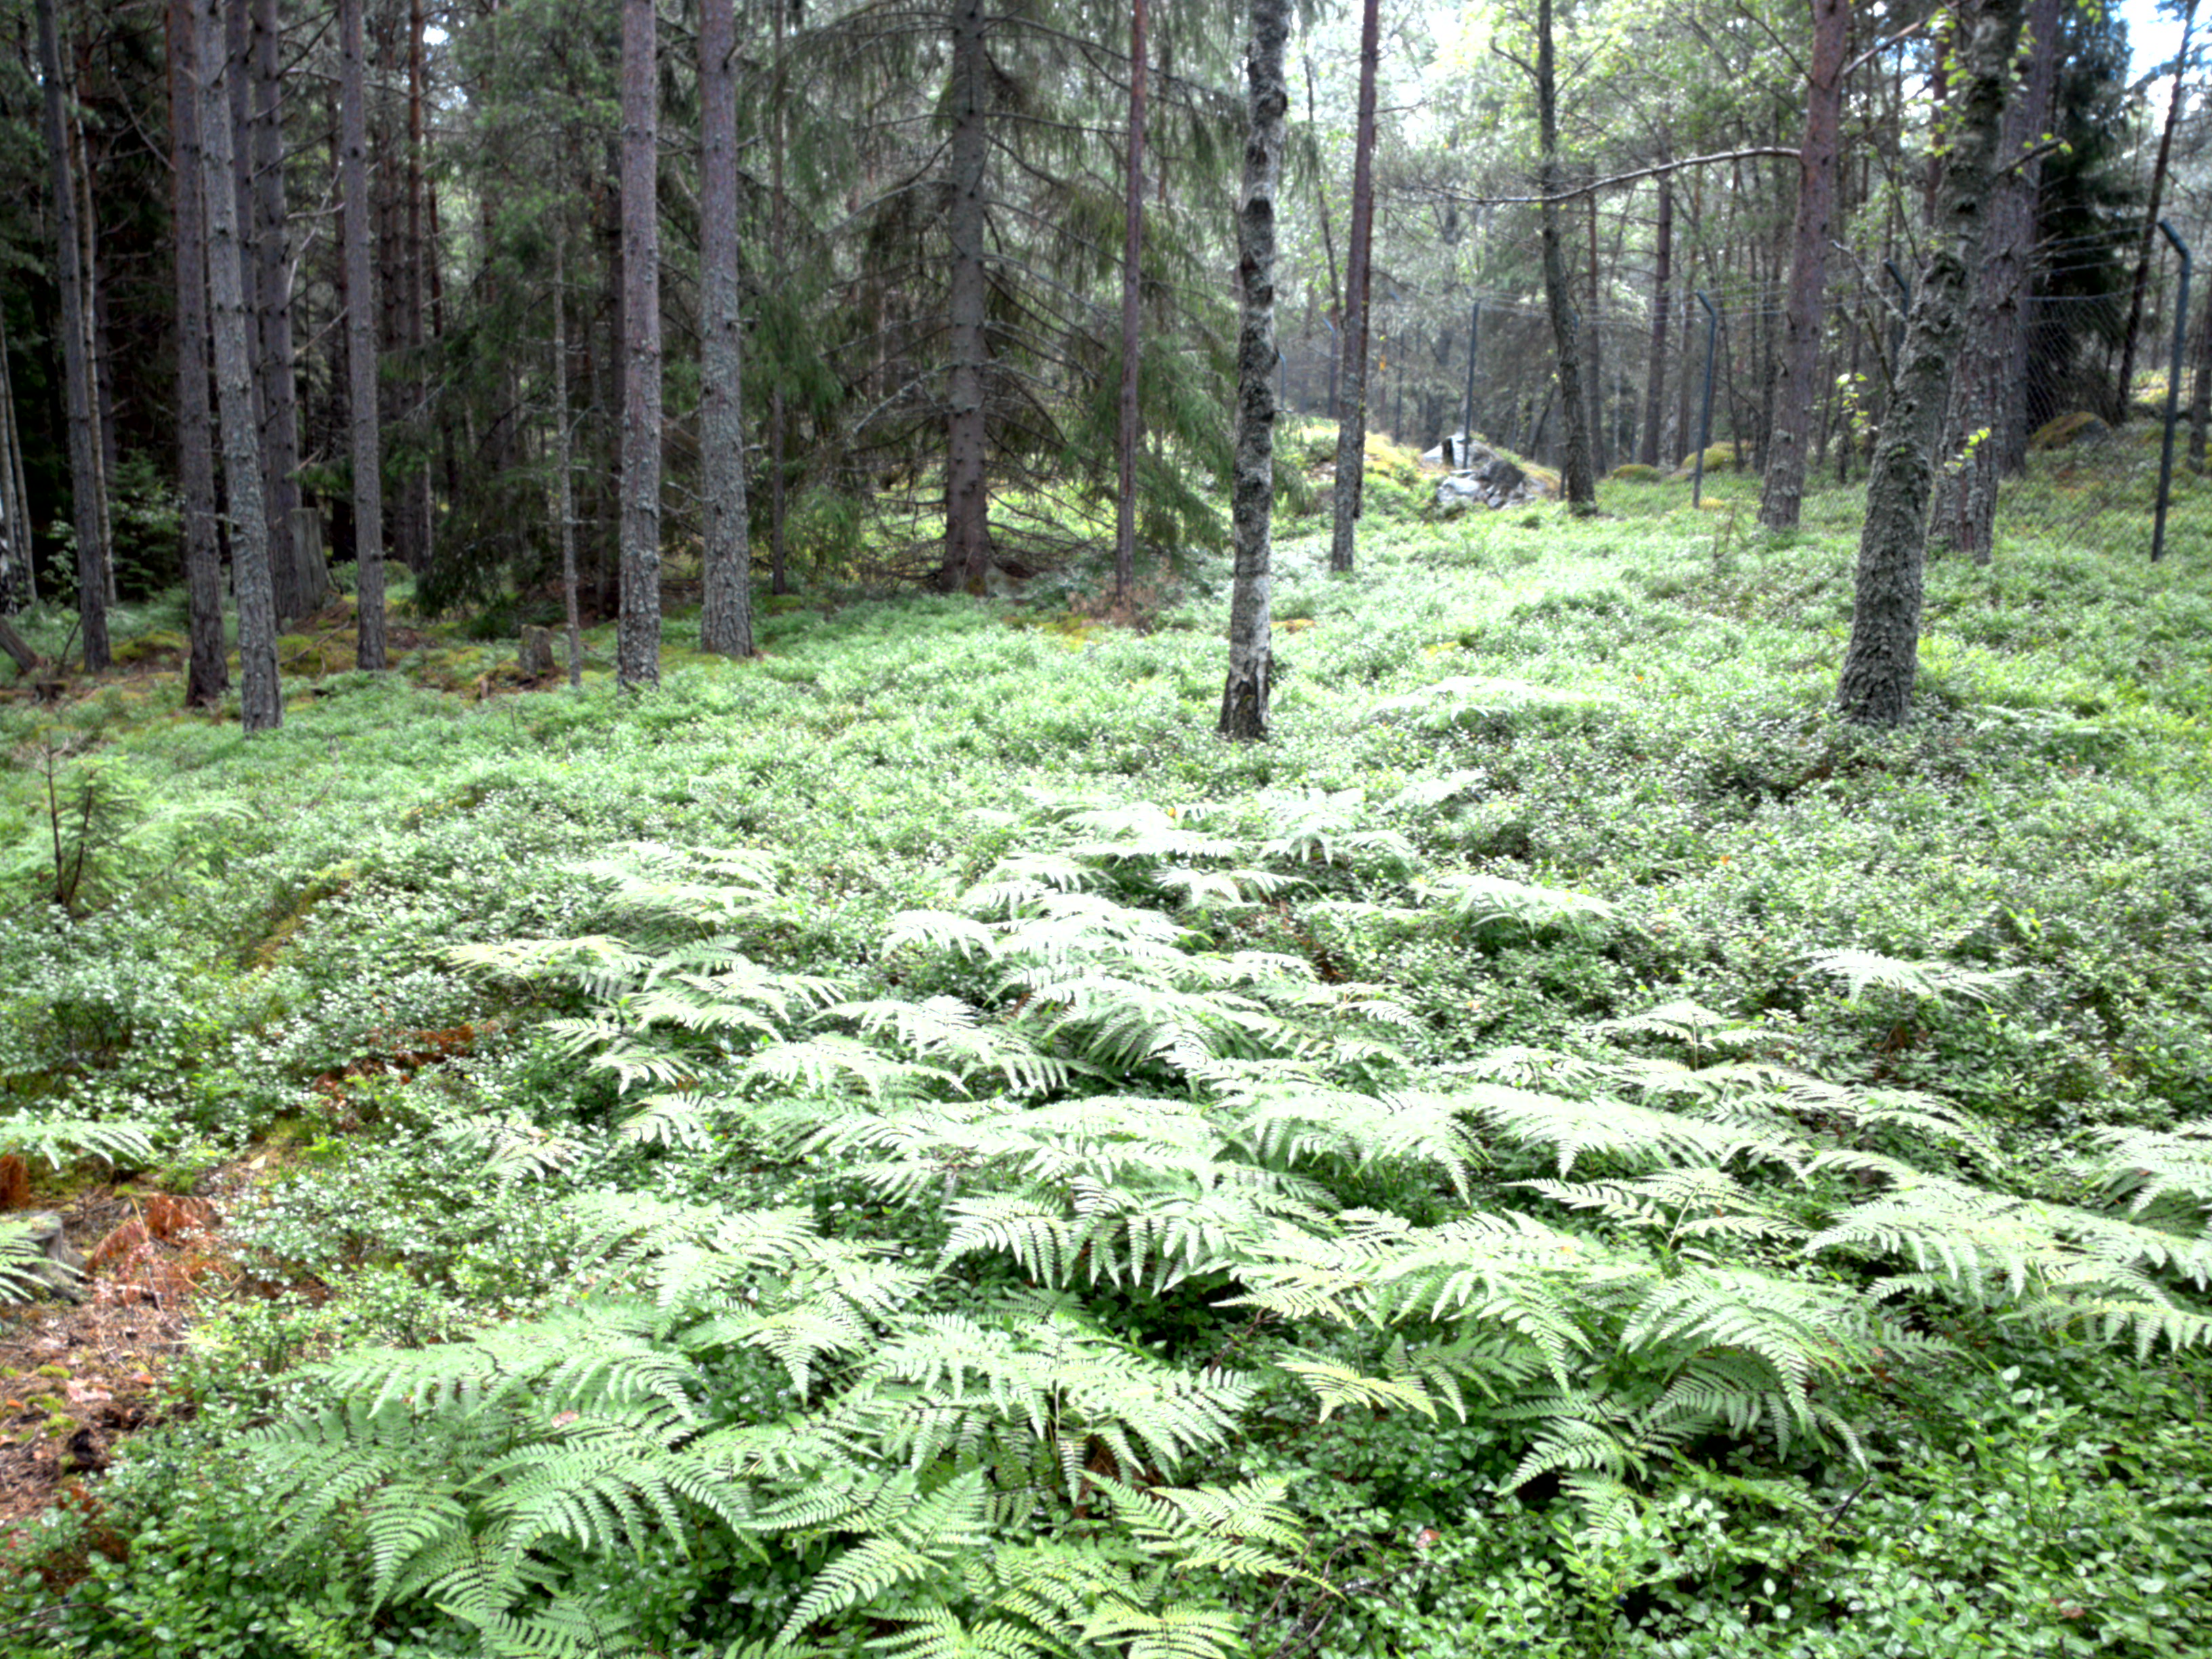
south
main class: Woodland
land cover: Pine dominated coniferous woodland
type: boreal forest
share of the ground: 50 - 75 %
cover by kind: coniferous forest trees 50 %, shrubs 30 %, broadleaved forest trees 10 %, herbaceous plants 10 %
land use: Forestry
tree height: > 5 m
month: July
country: SE
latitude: 59.0717
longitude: 18.2166
